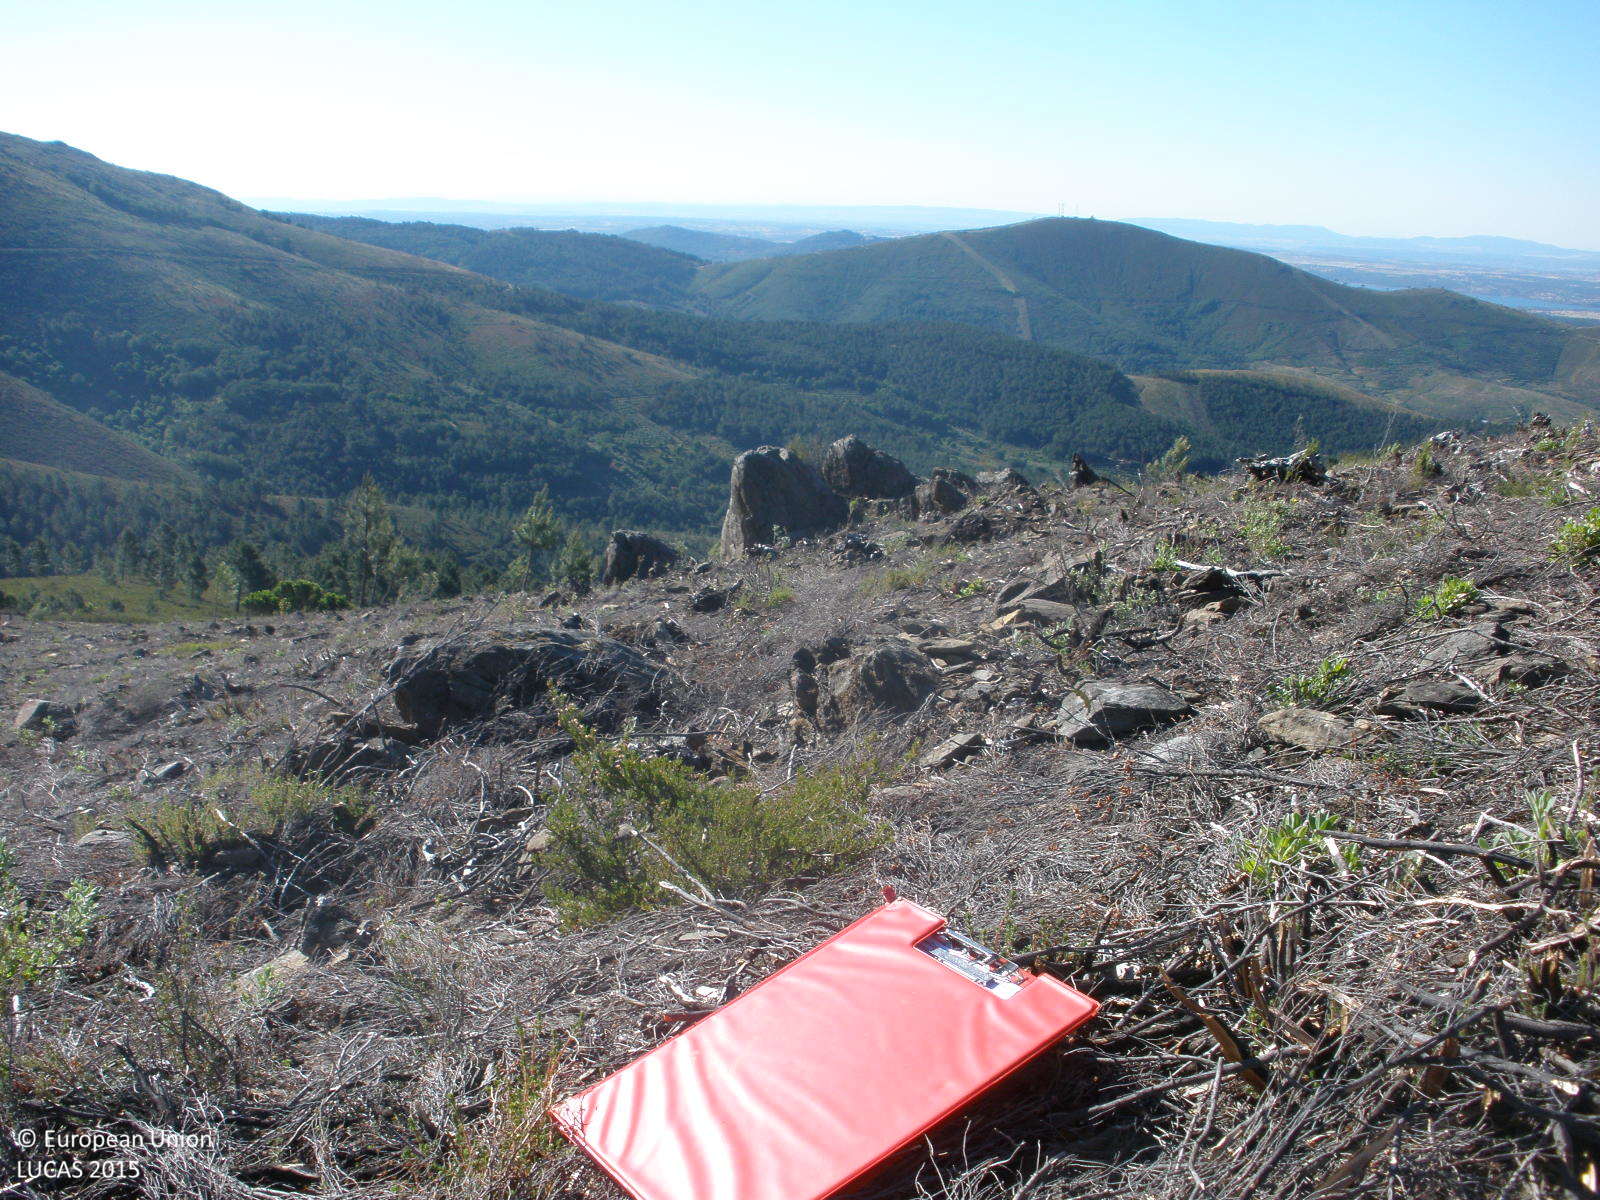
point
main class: Shrubland
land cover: Shrubland without tree cover
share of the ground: 50 - 75 %
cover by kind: consolidated bare surface 60 %, shrubs 40 %
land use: Forestry
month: May
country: ES
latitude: 40.2556
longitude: -6.6288
